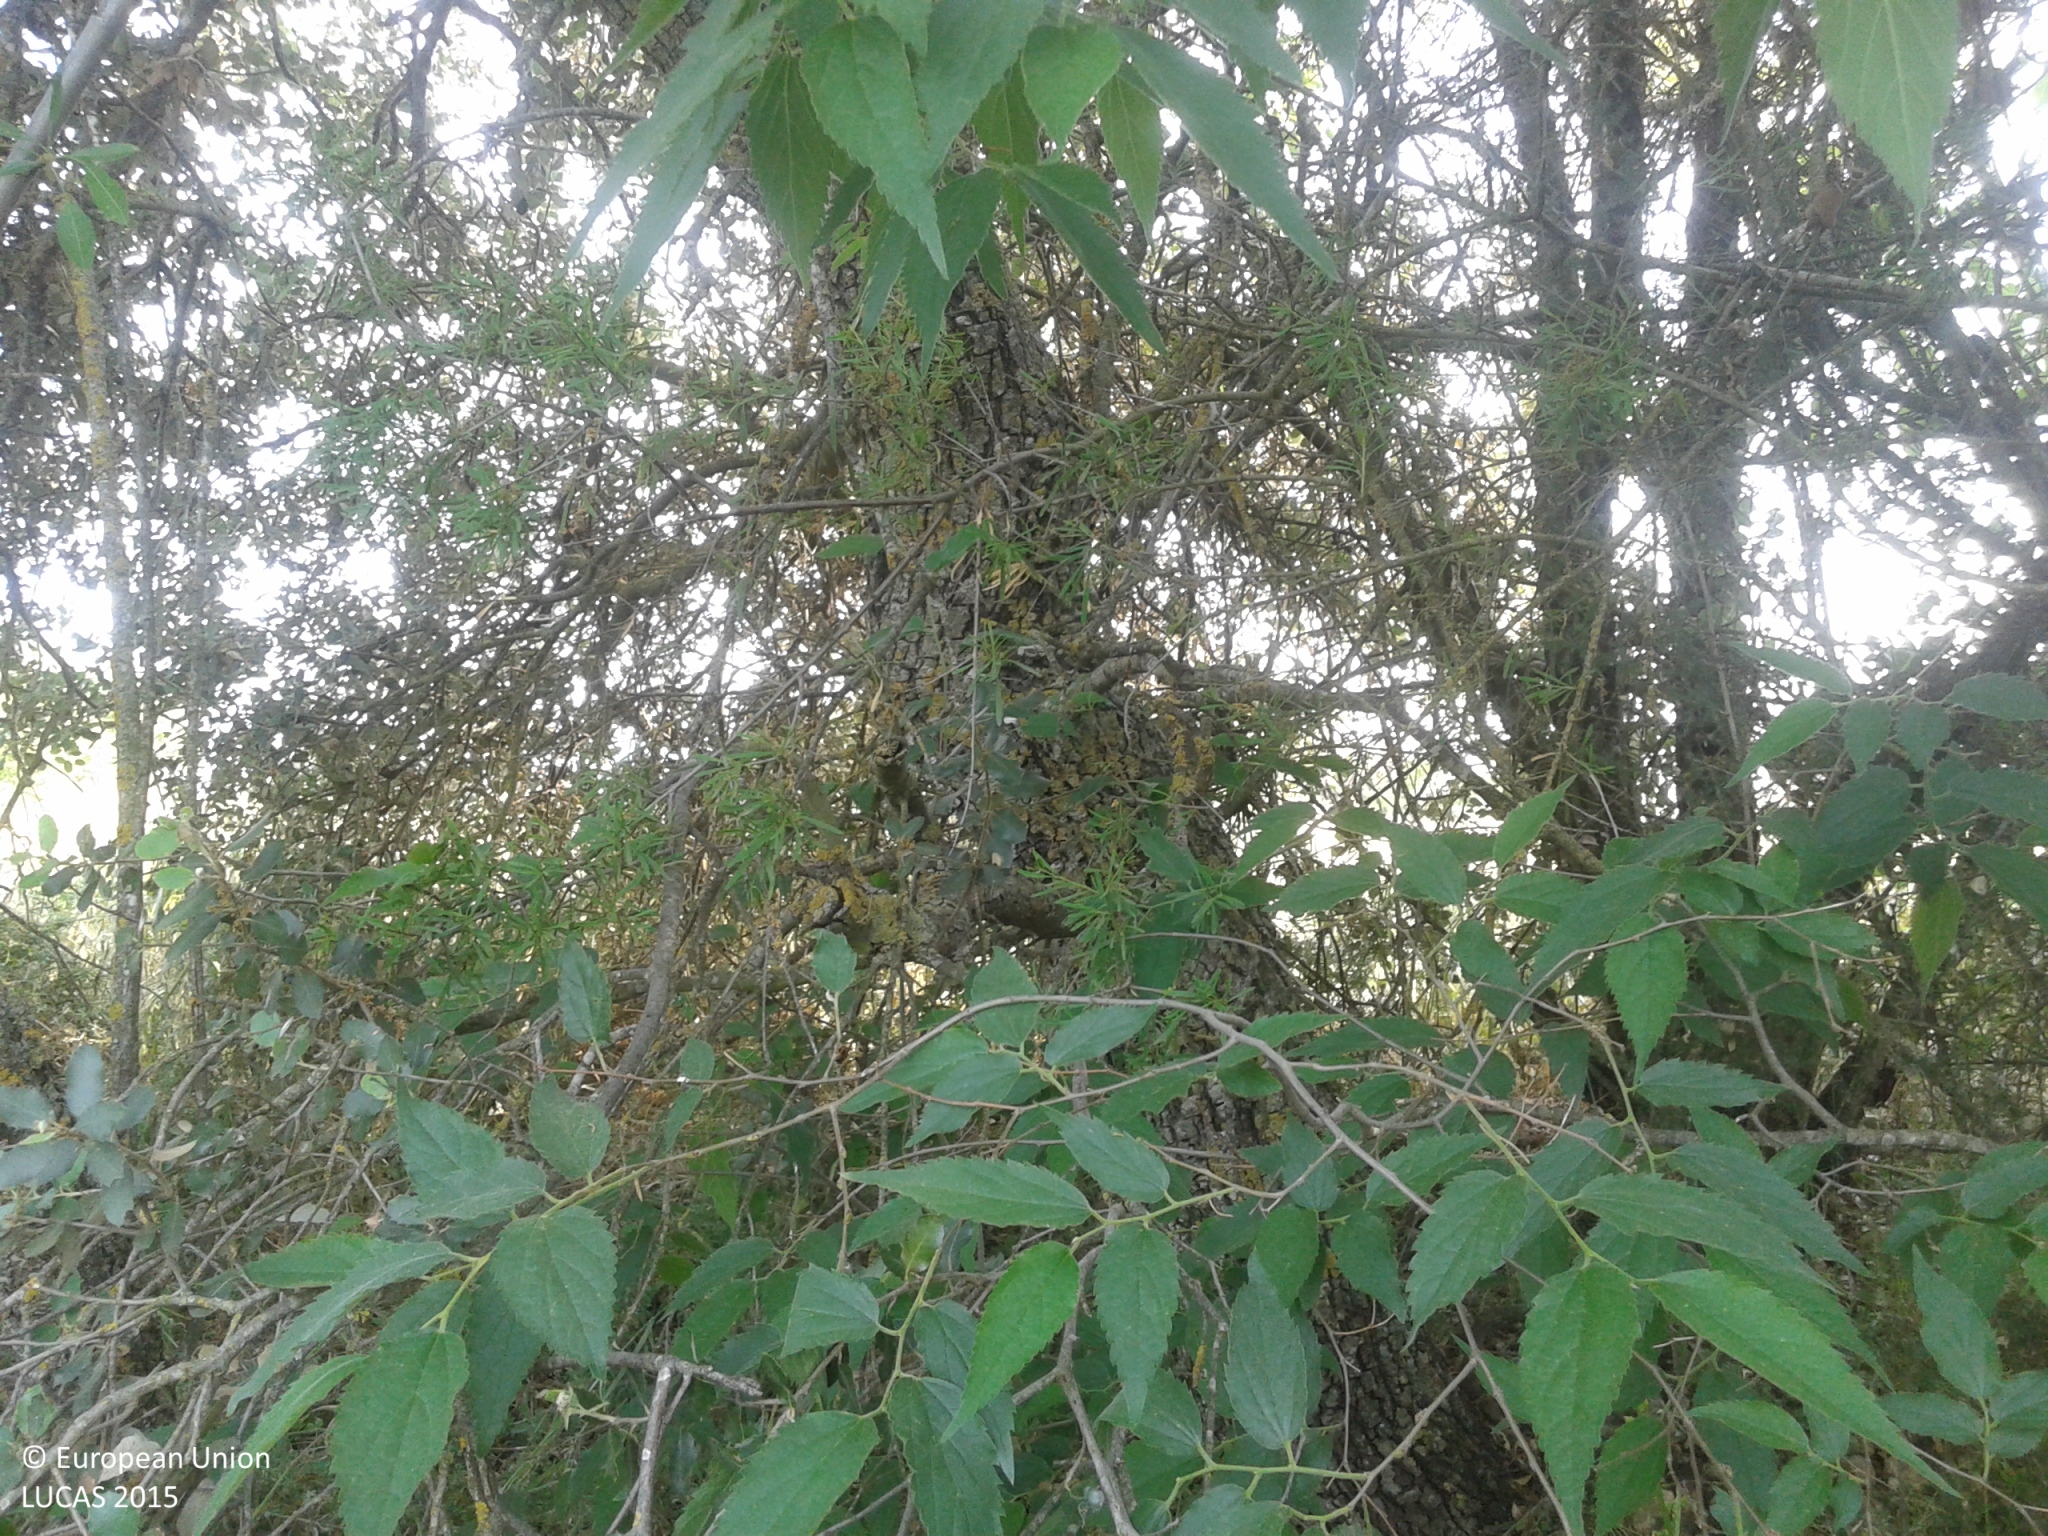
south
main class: Woodland
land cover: Broadleaved woodland
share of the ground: > 75 %
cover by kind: broadleaved forest trees 90 %, shrubs 5 %, herbaceous plants 5 %
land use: Semi-natural and natural areas not in use
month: May
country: ES
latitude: 41.8371
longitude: 0.6292
